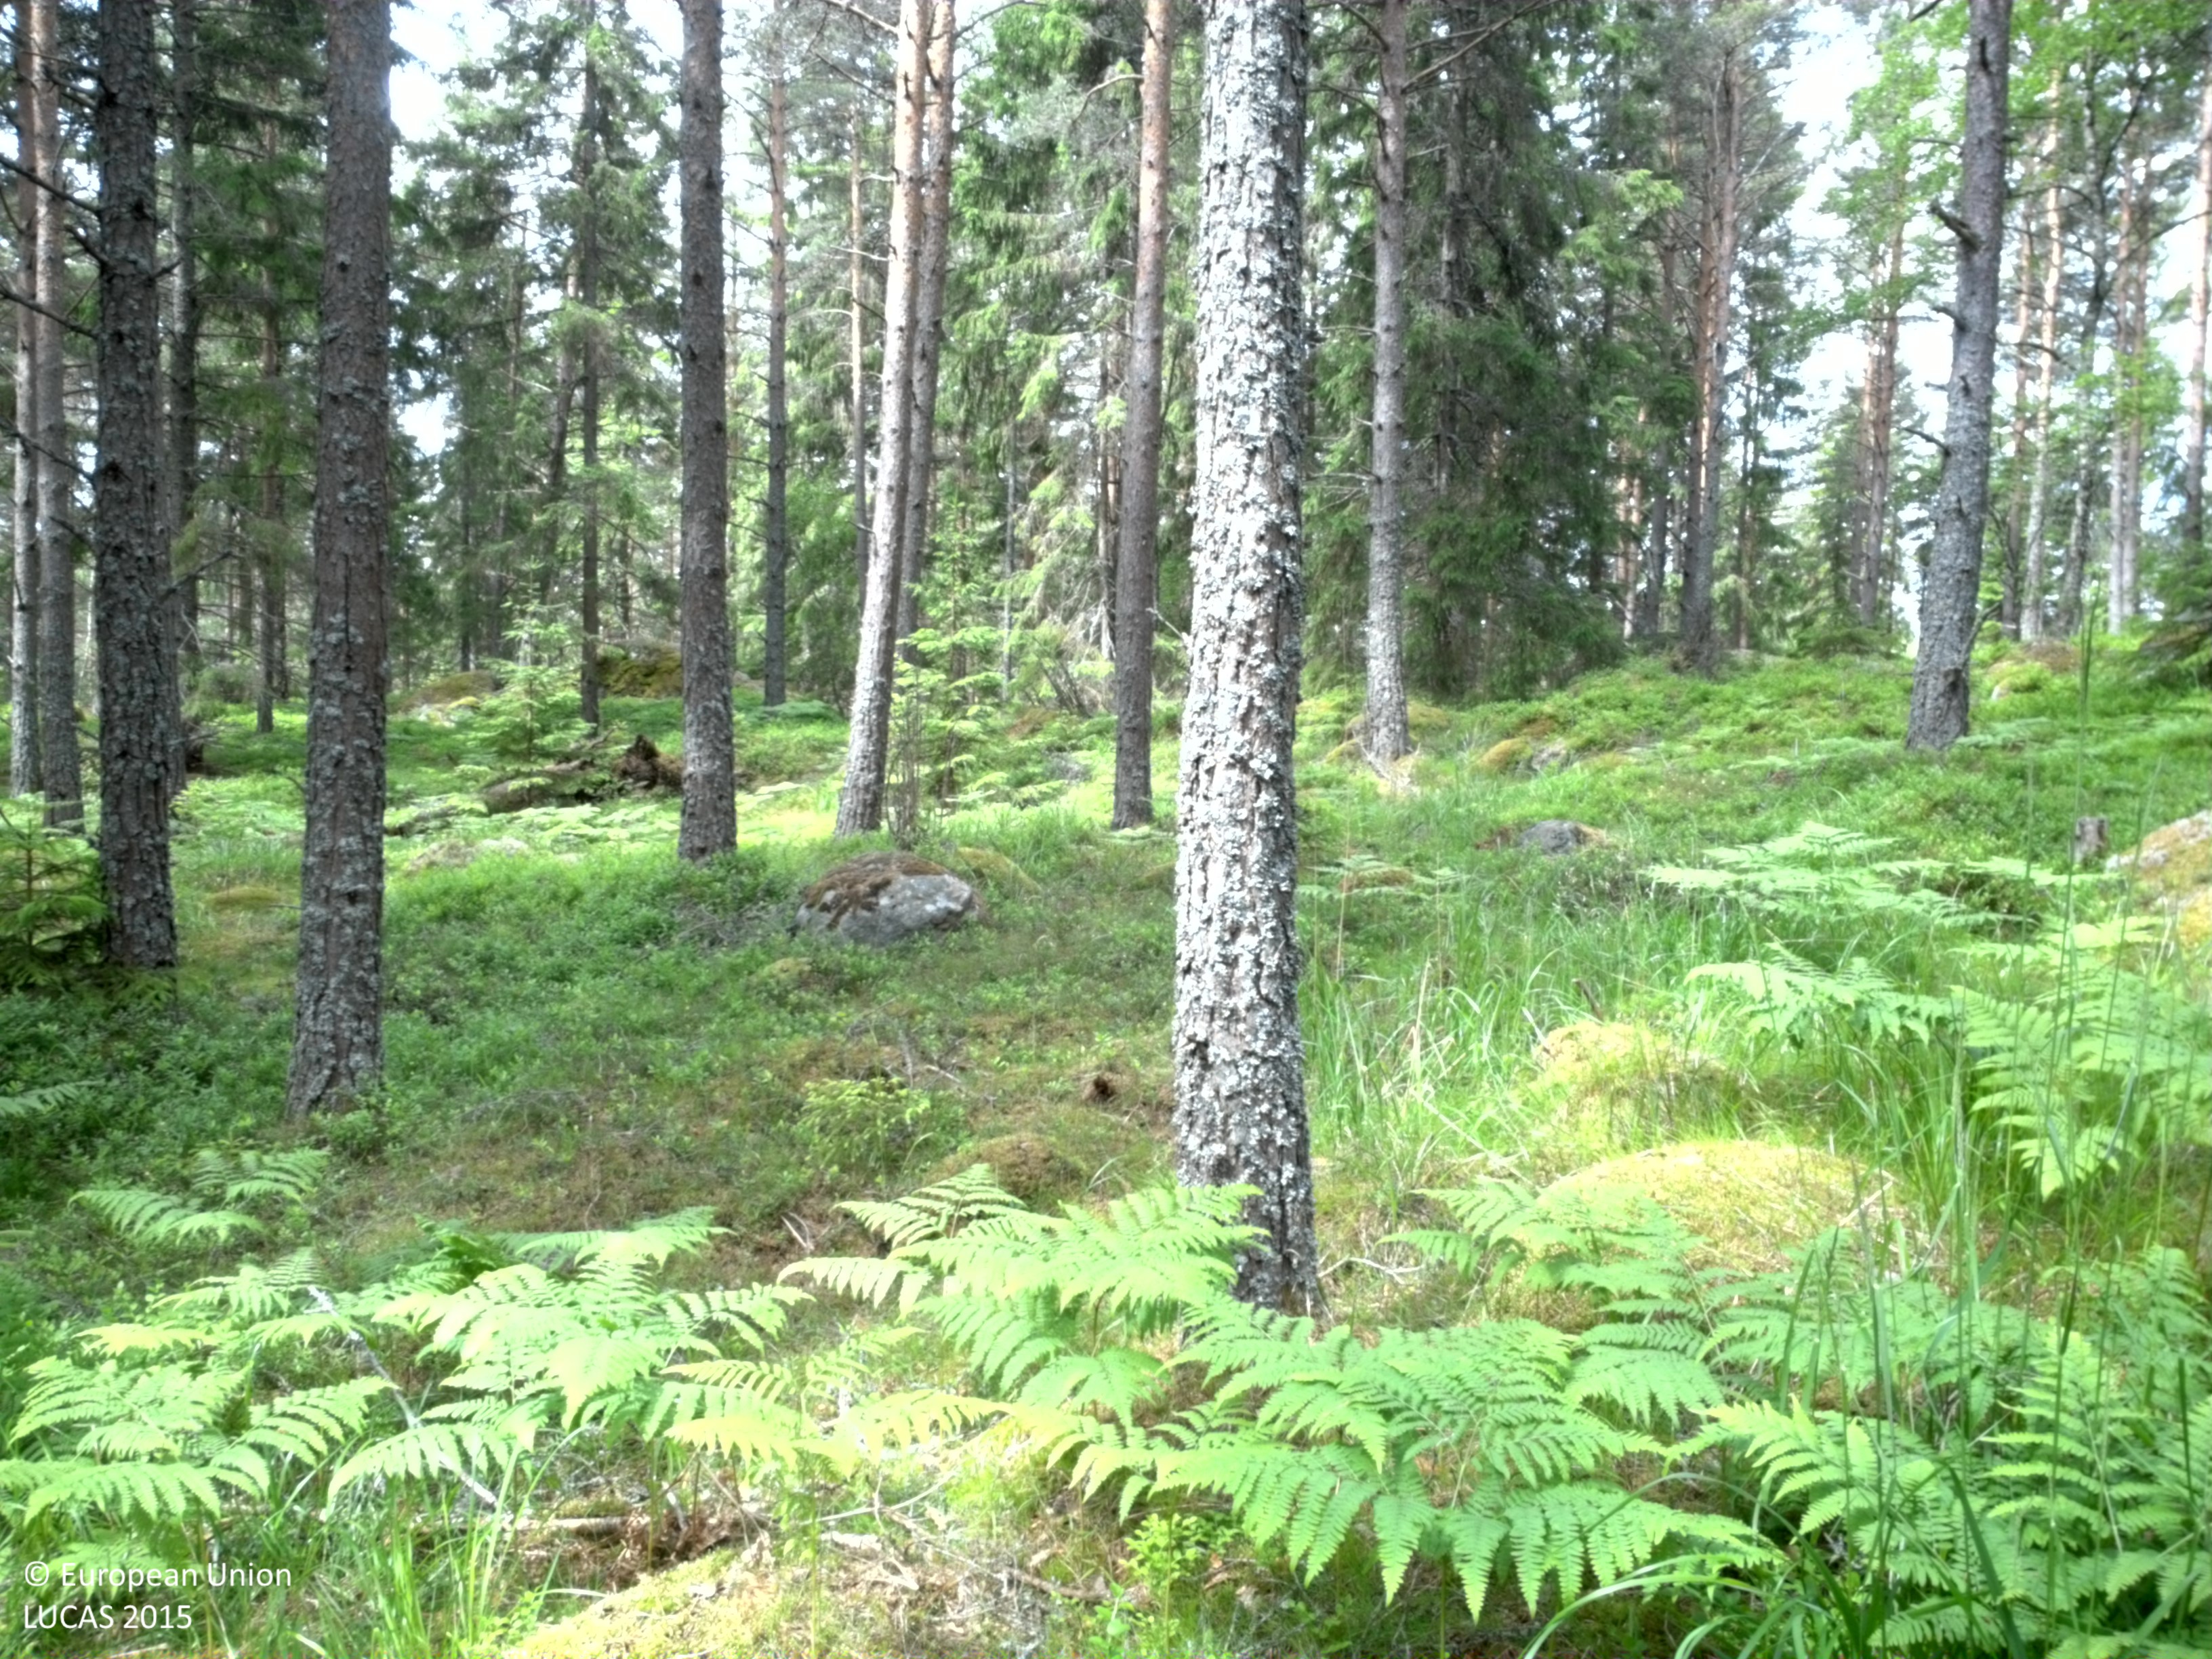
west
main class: Woodland
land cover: Pine dominated coniferous woodland
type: boreal forest
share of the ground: 25 - 50 %
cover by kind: herbaceous plants 55 %, coniferous forest trees 35 %, lichens and mosses 10 %
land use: Forestry
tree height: > 5 m
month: June
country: SE
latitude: 58.5697
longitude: 15.6508
